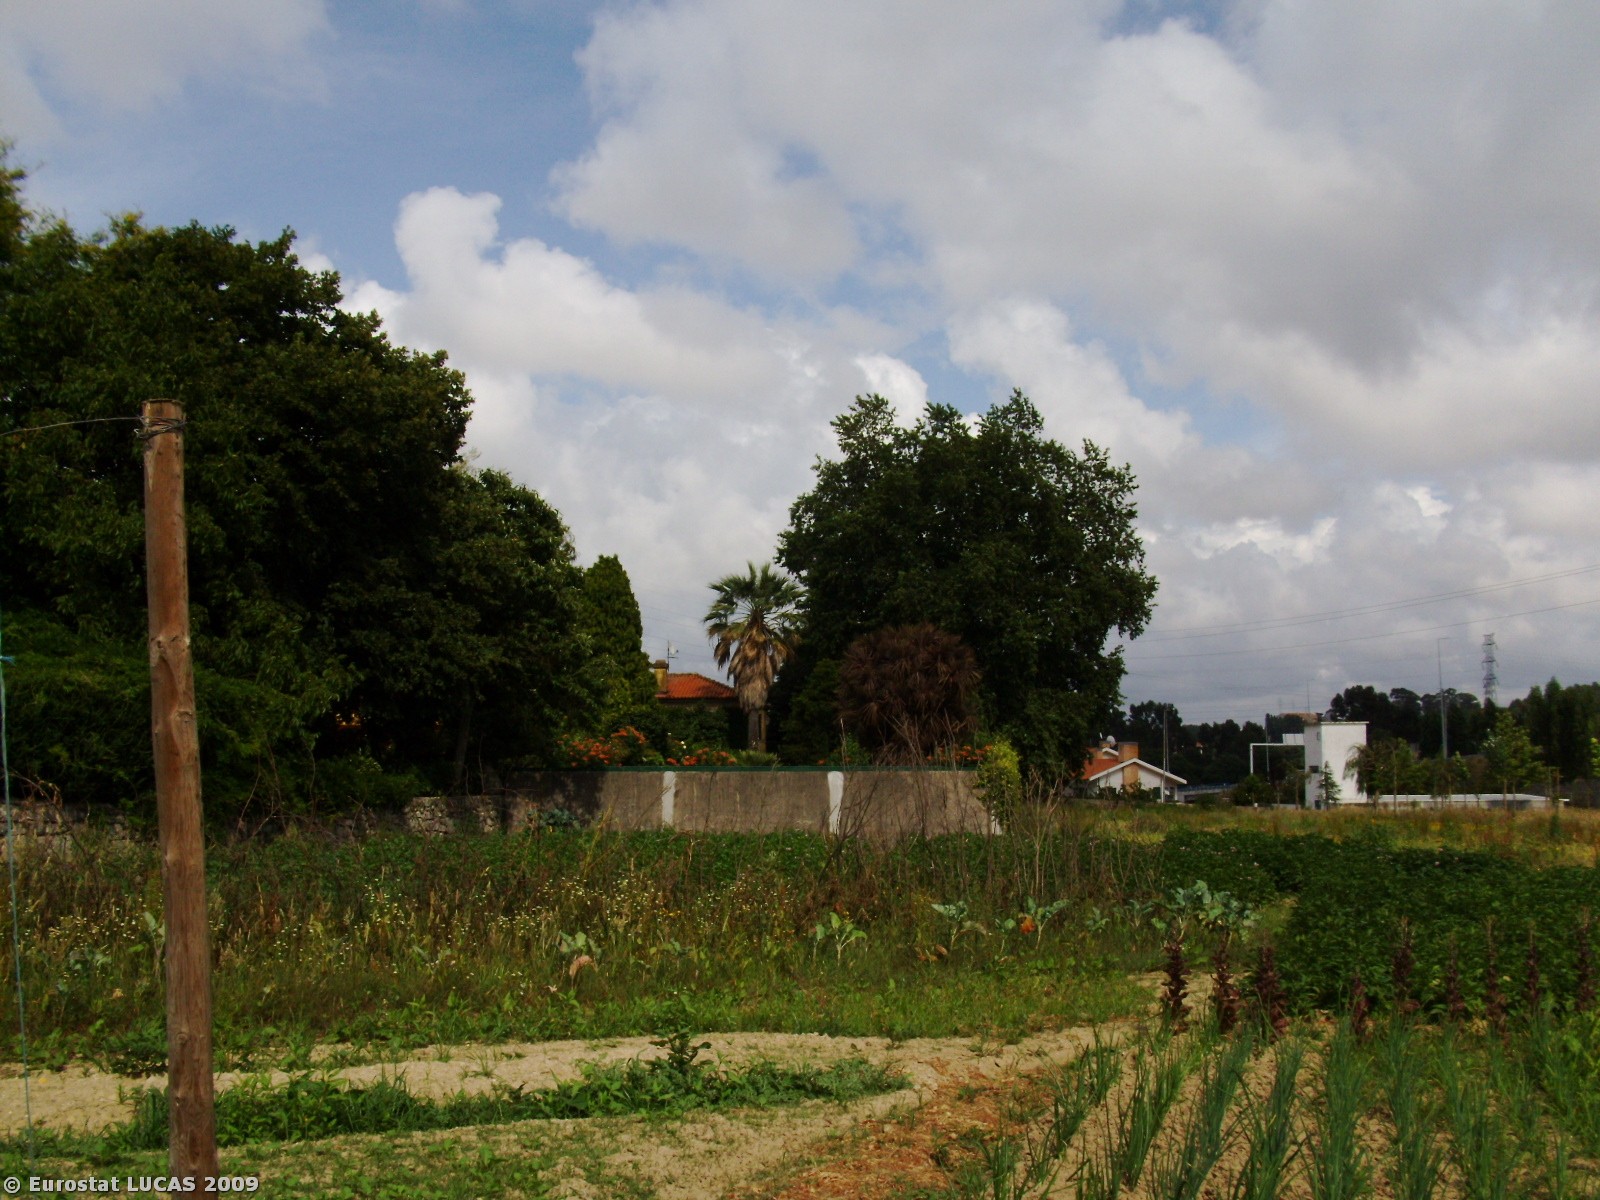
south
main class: Cropland
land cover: Other fresh vegetables
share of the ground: 50 - 75 %
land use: Agriculture (excluding fallow land and kitchen gardens)
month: June
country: PT
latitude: 41.2038
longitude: -8.6263
